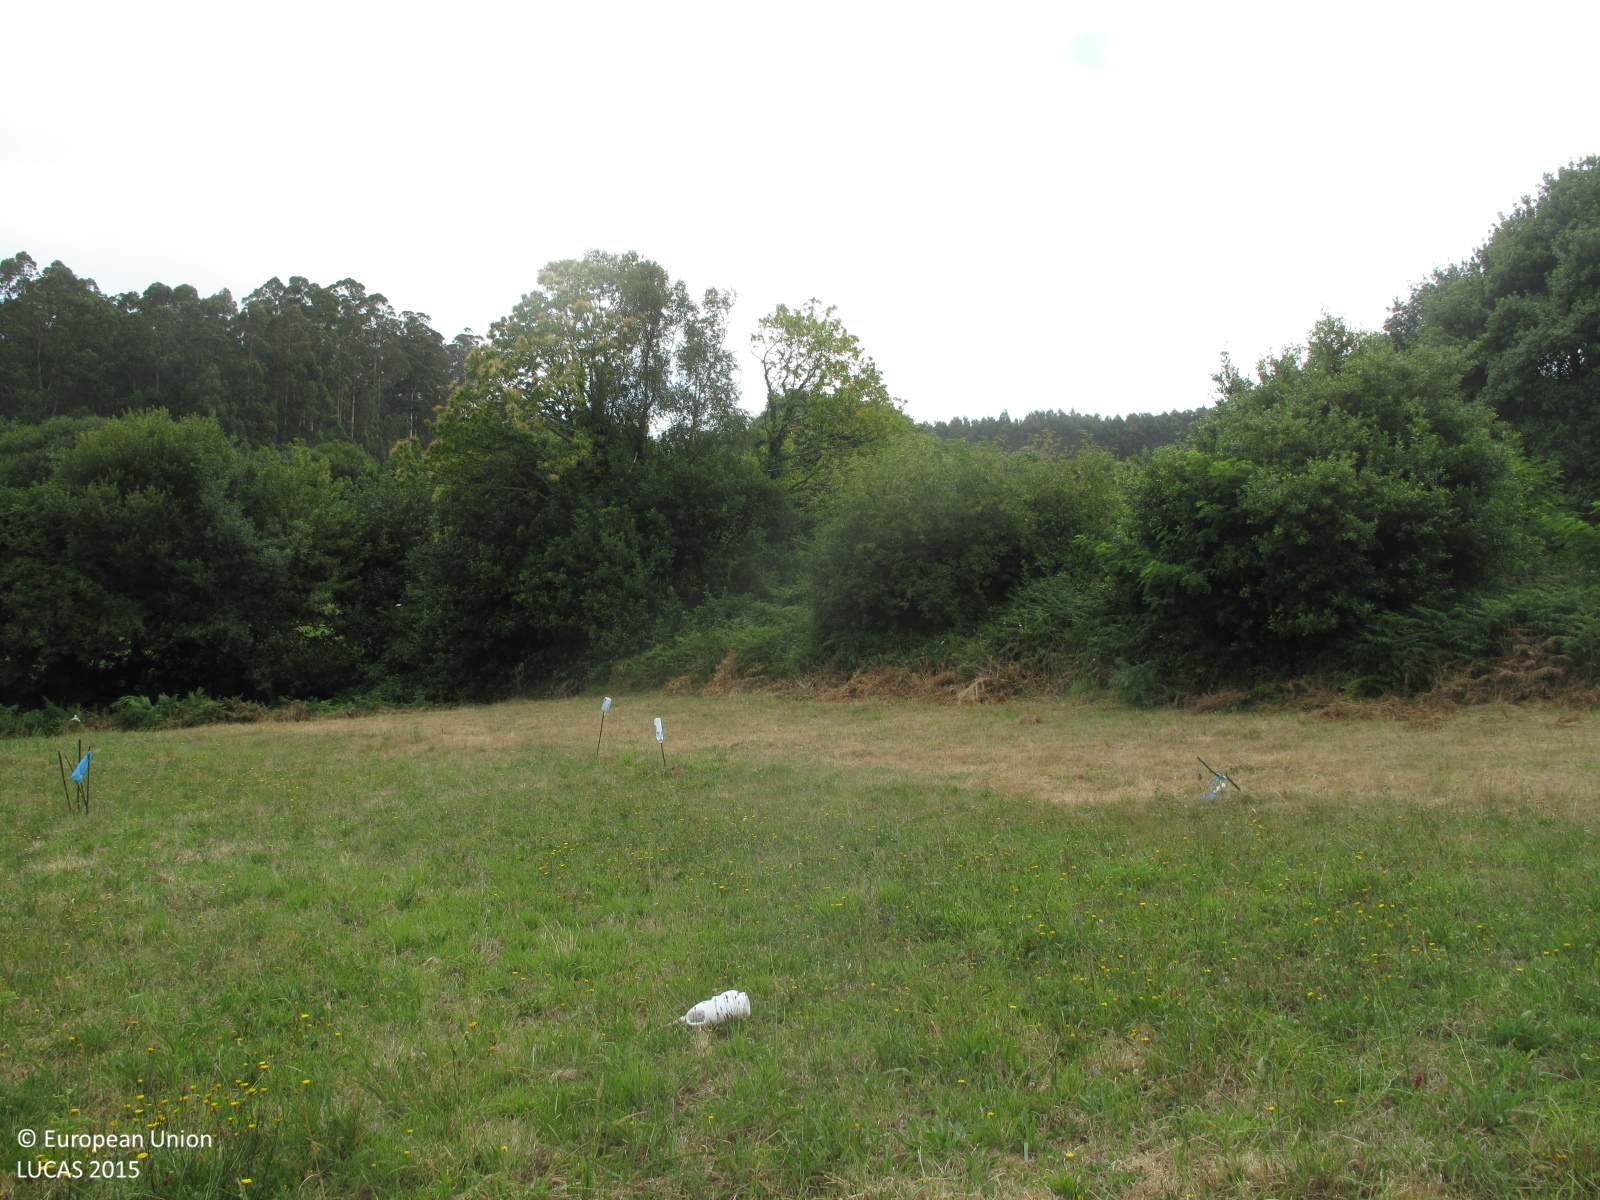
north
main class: Grassland
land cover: Grassland without tree/shrub cover
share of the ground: > 75 %
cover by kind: herbaceous plants 100 %
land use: Abandoned areas
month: July
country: ES
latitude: 43.6091
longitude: -8.1029
